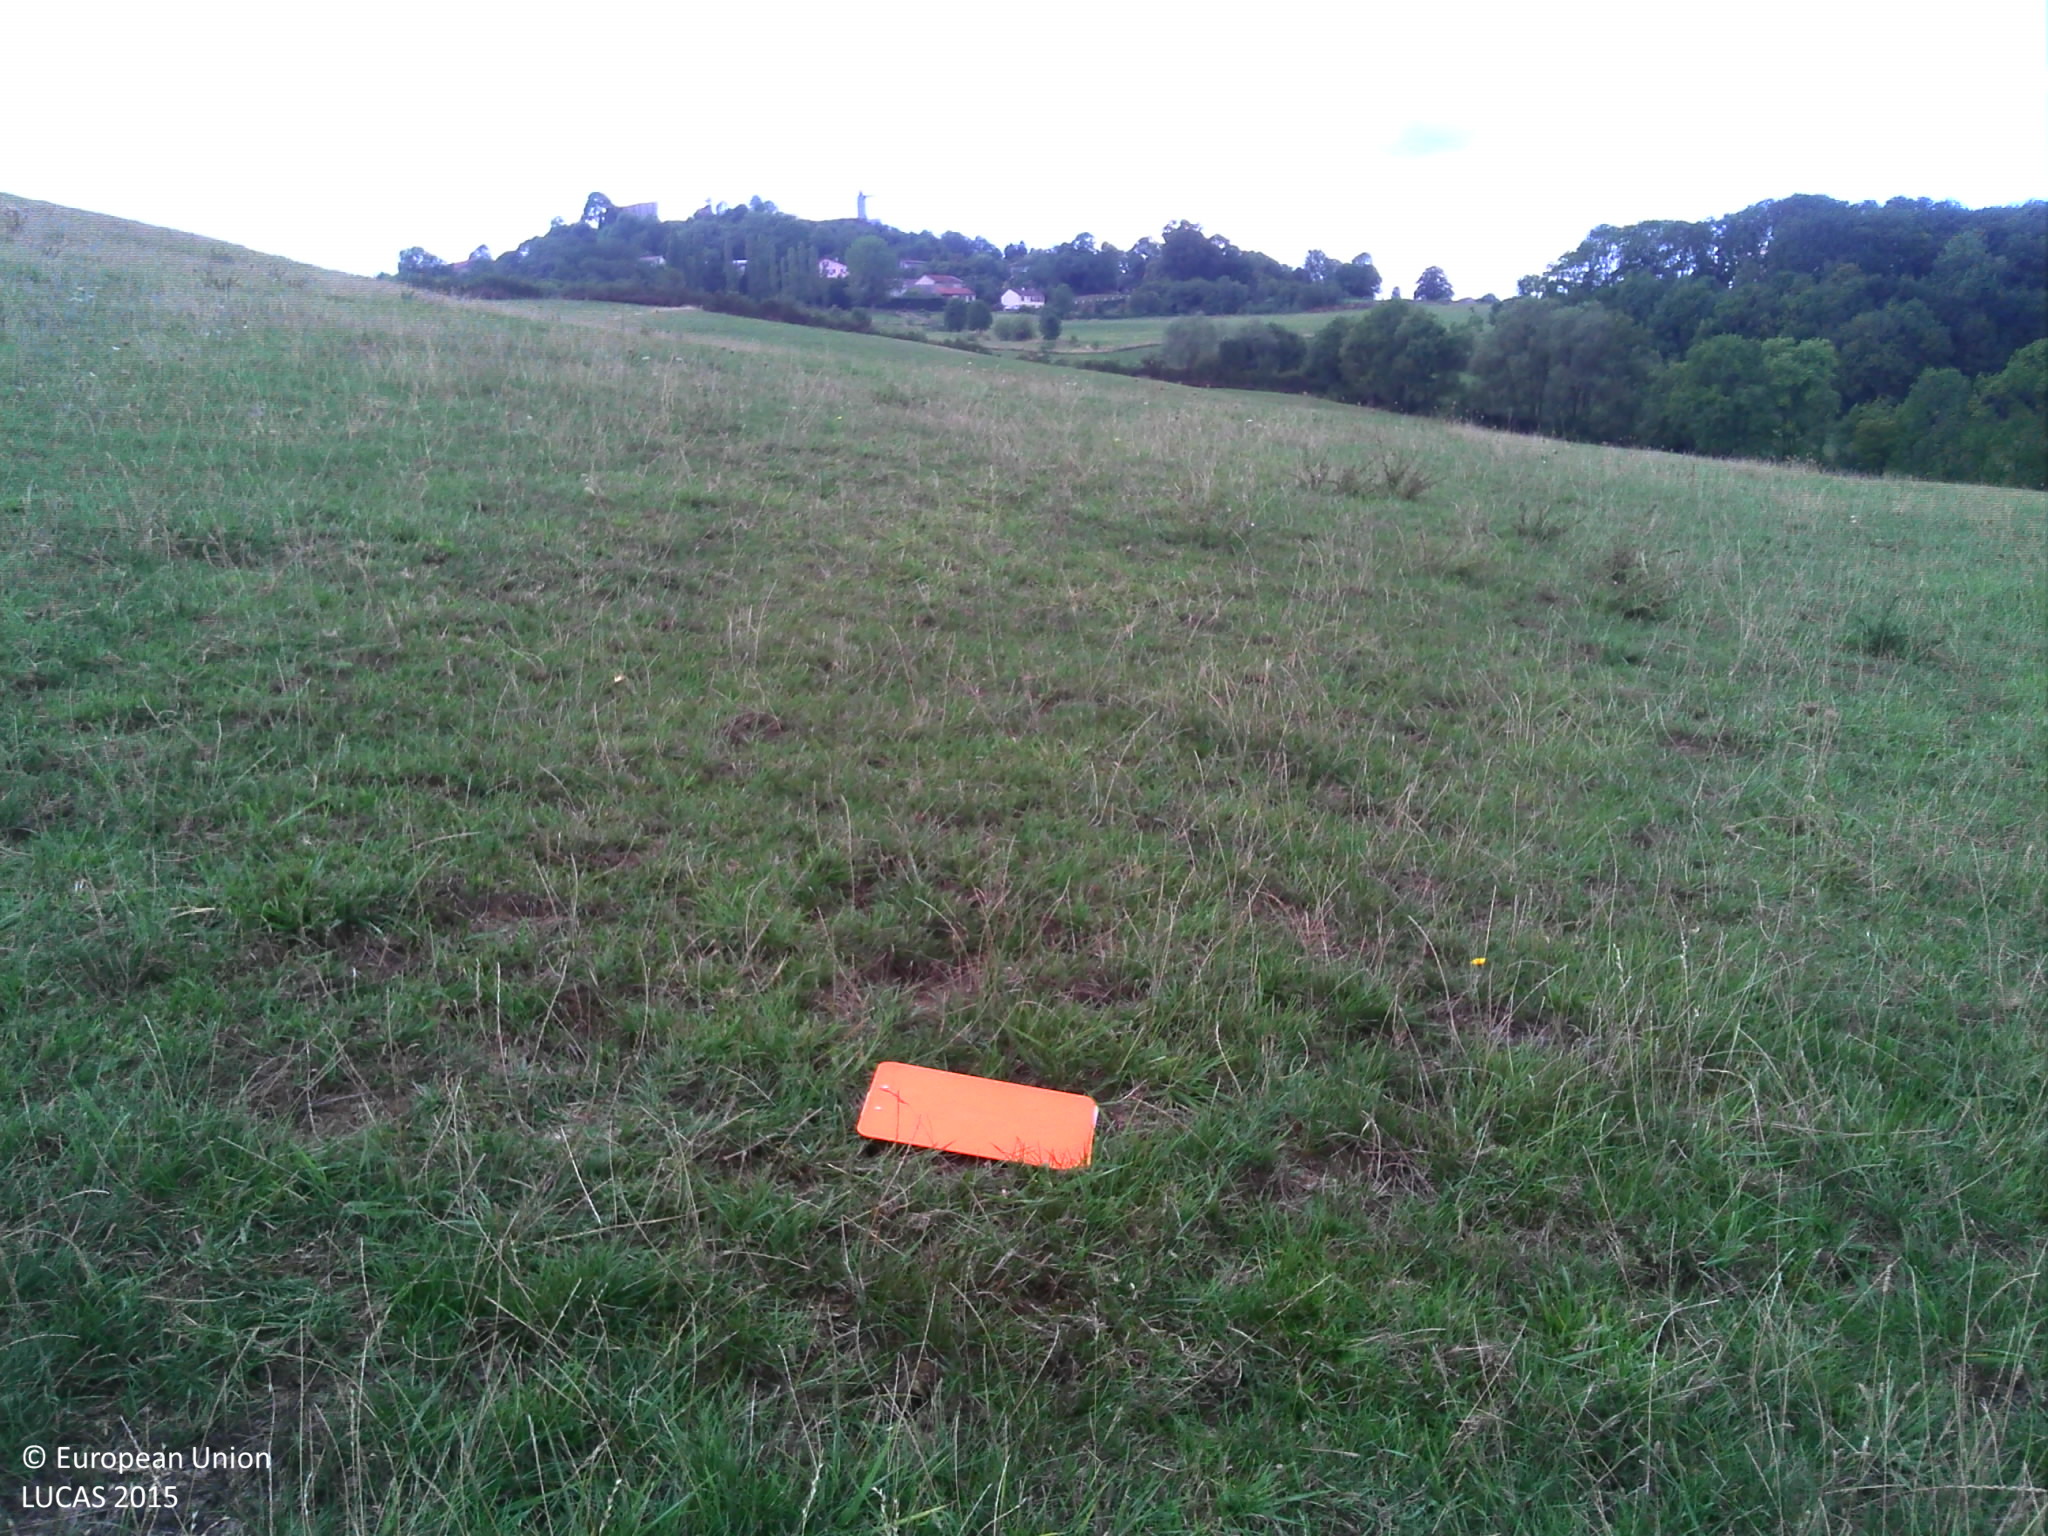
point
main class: Grassland
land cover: Grassland without tree/shrub cover
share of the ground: > 75 %
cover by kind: herbaceous plants 95 %, unconsolidated bare surface 5 %
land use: Agriculture (excluding fallow land and kitchen gardens)
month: September
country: FR
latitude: 48.9106
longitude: 6.0838
